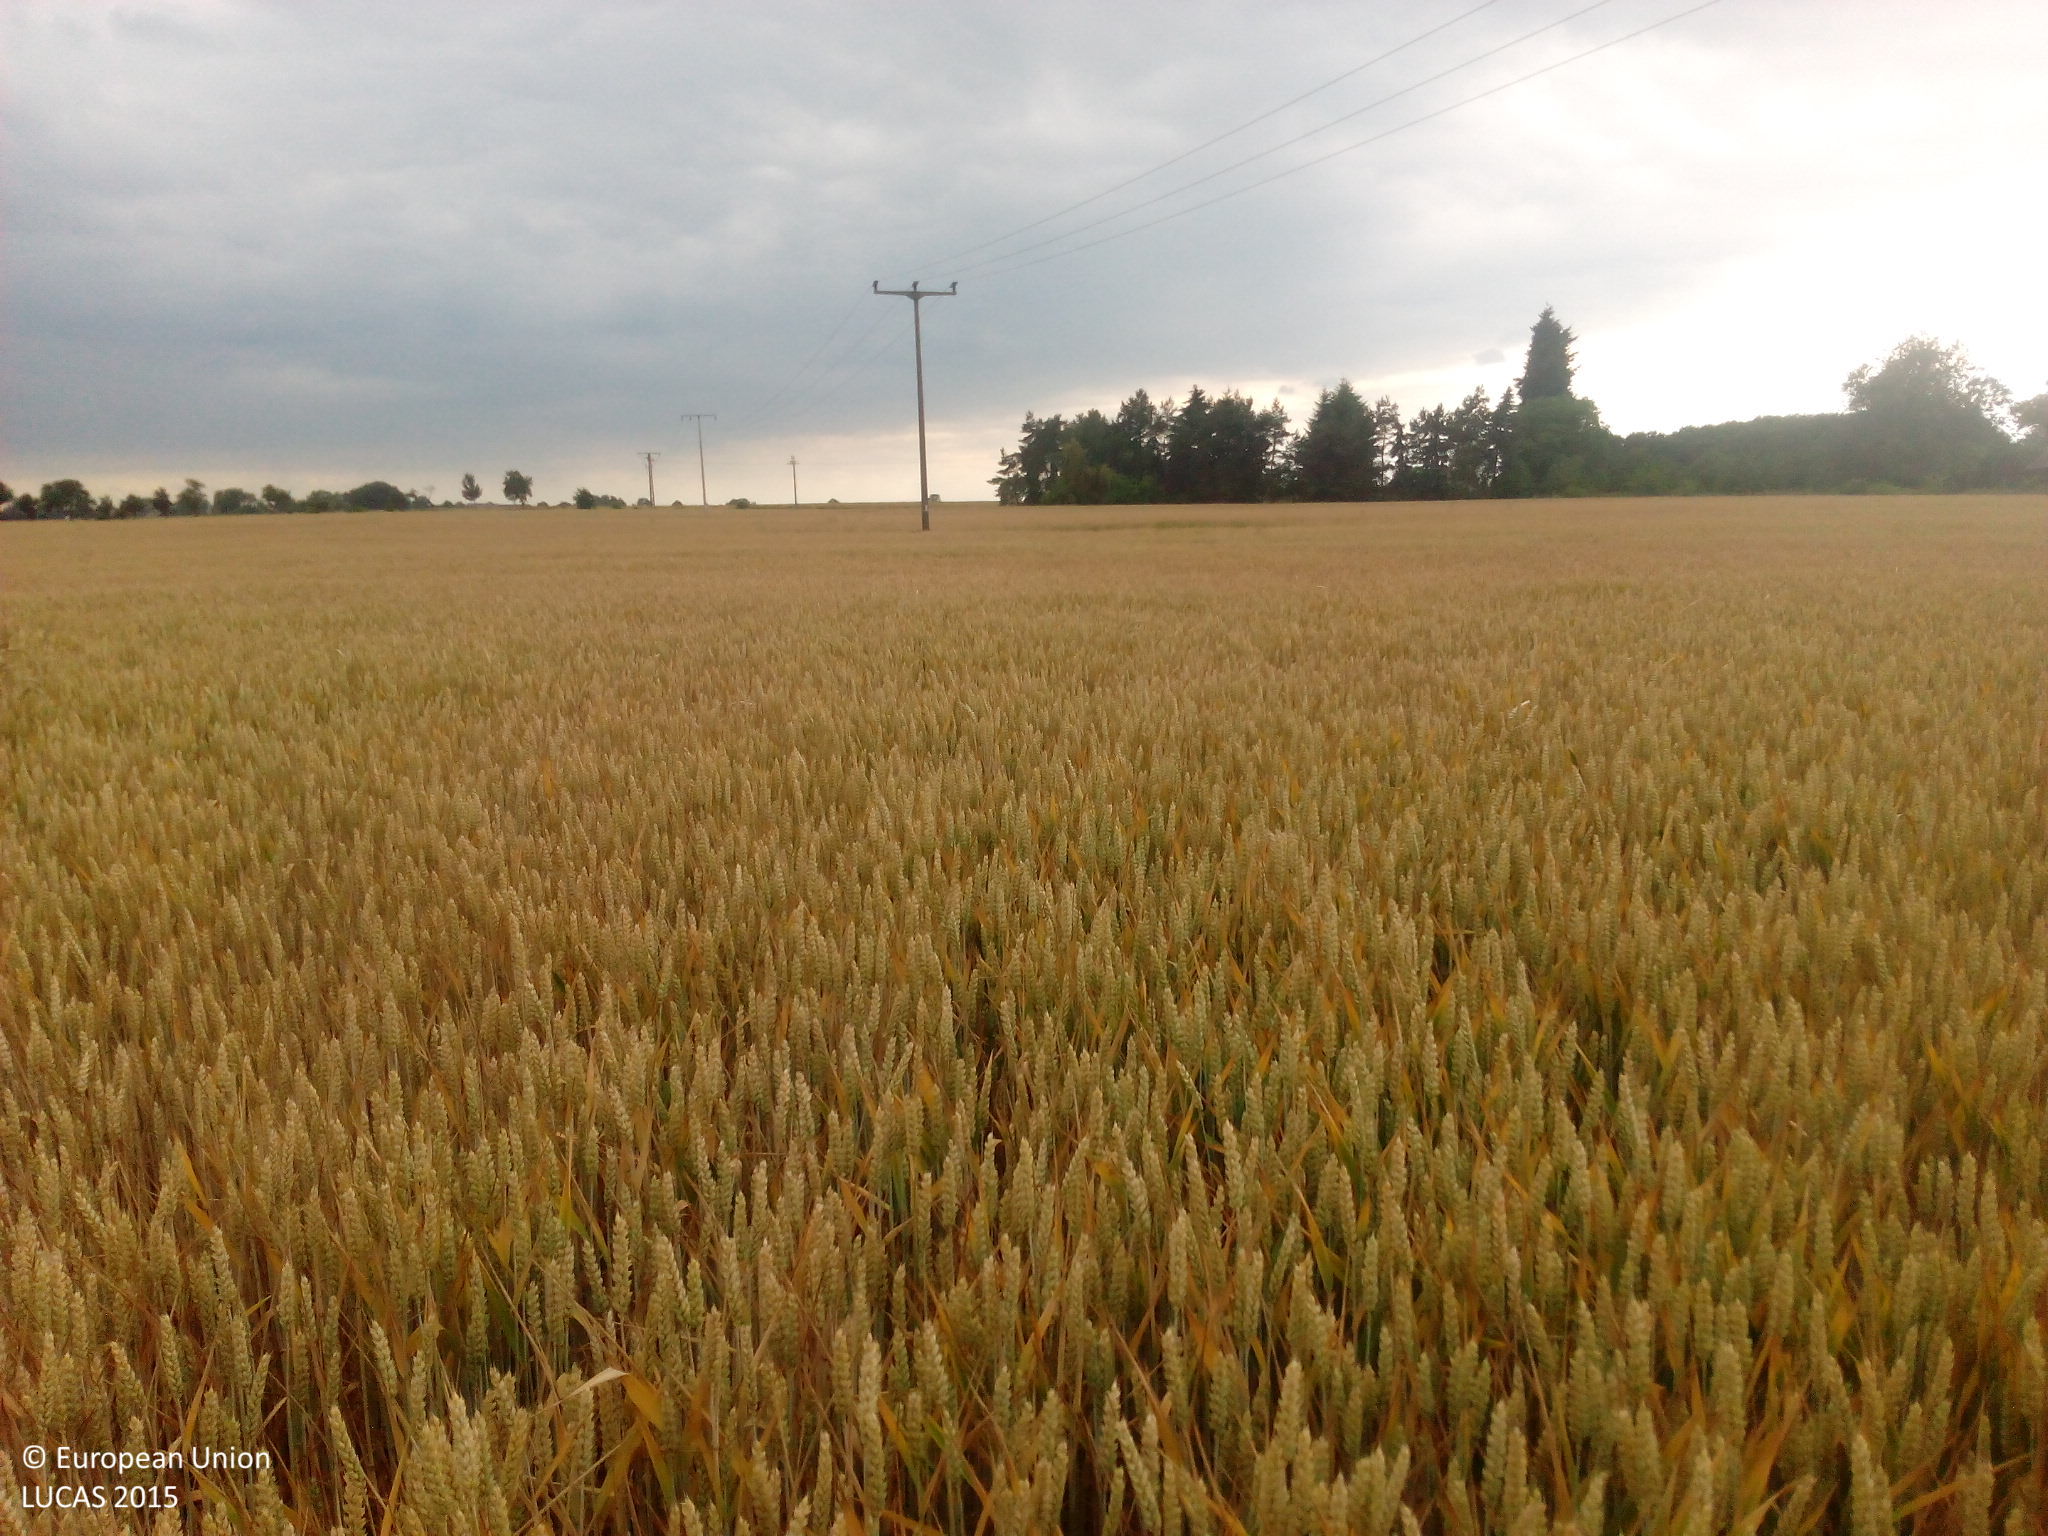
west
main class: Cropland
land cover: Common wheat
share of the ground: > 75 %
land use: Agriculture (excluding fallow land and kitchen gardens)
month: July
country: DE
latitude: 52.9120
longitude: 12.3341
